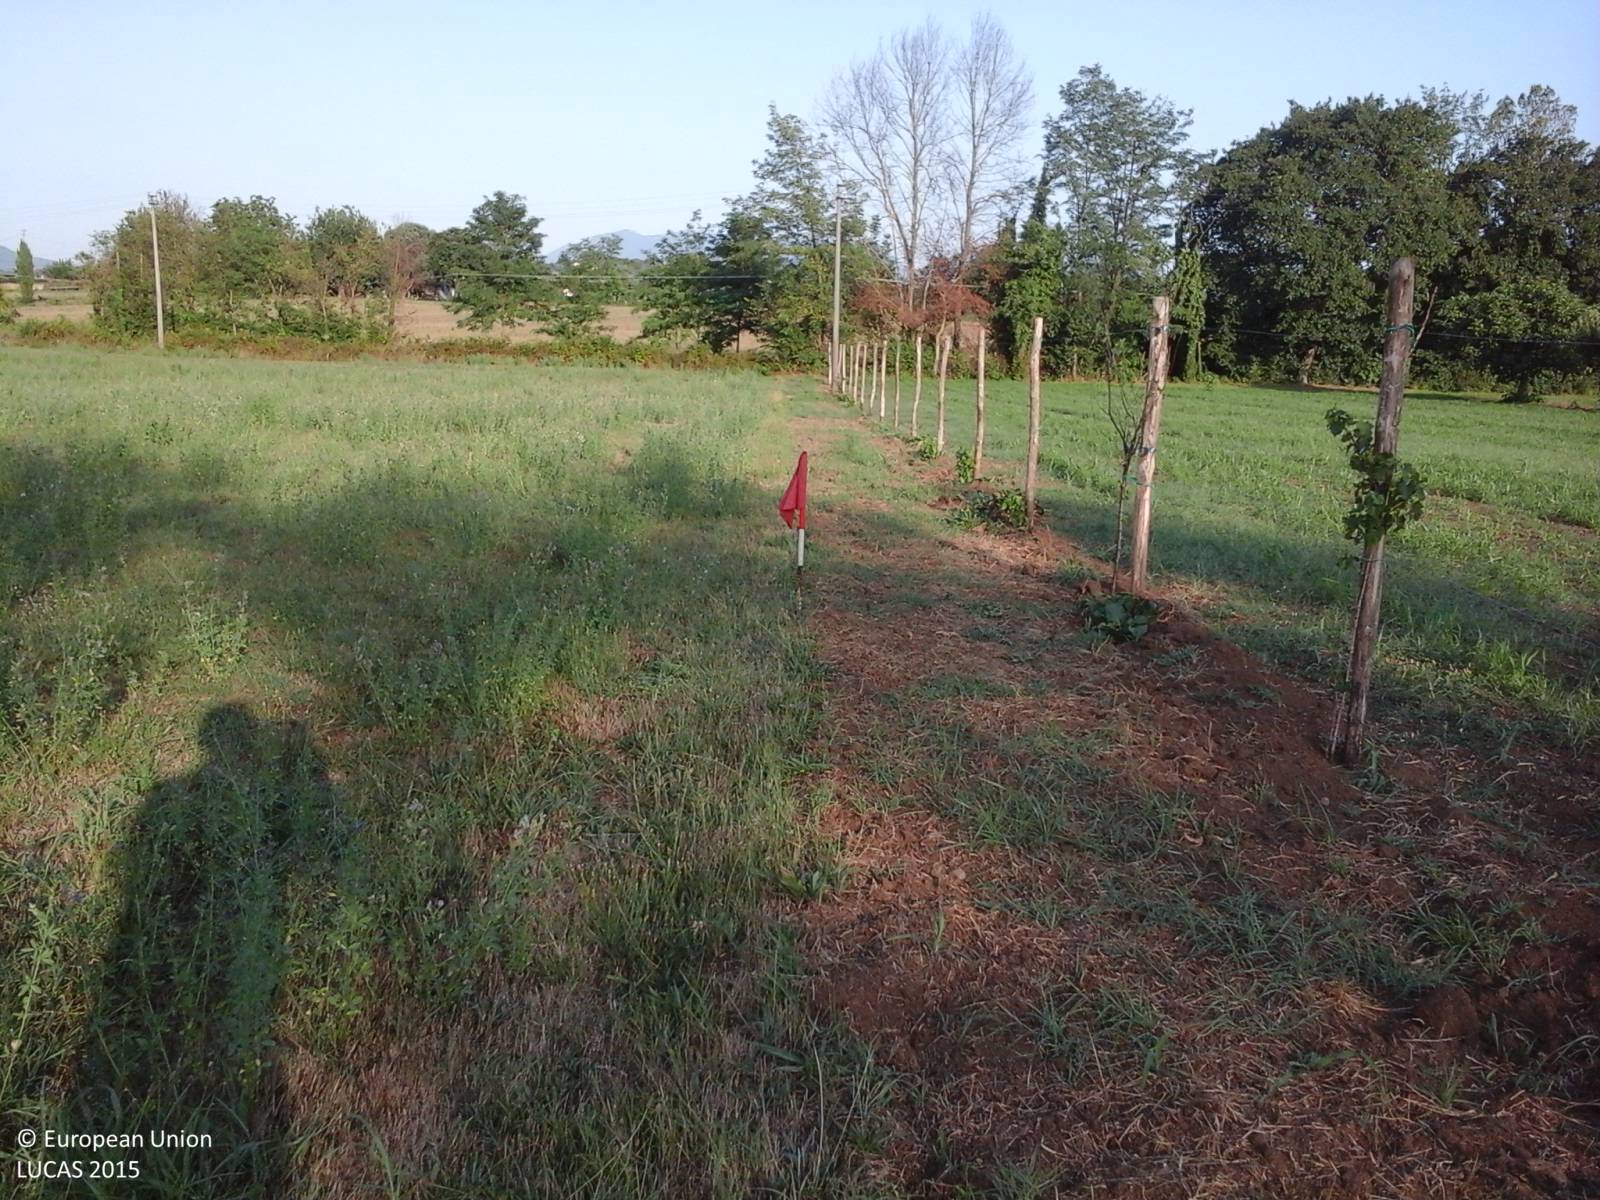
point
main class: Cropland
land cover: Lucerne
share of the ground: > 75 %
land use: Agriculture (excluding fallow land and kitchen gardens)
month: July
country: IT
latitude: 41.2582
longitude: 14.3398
